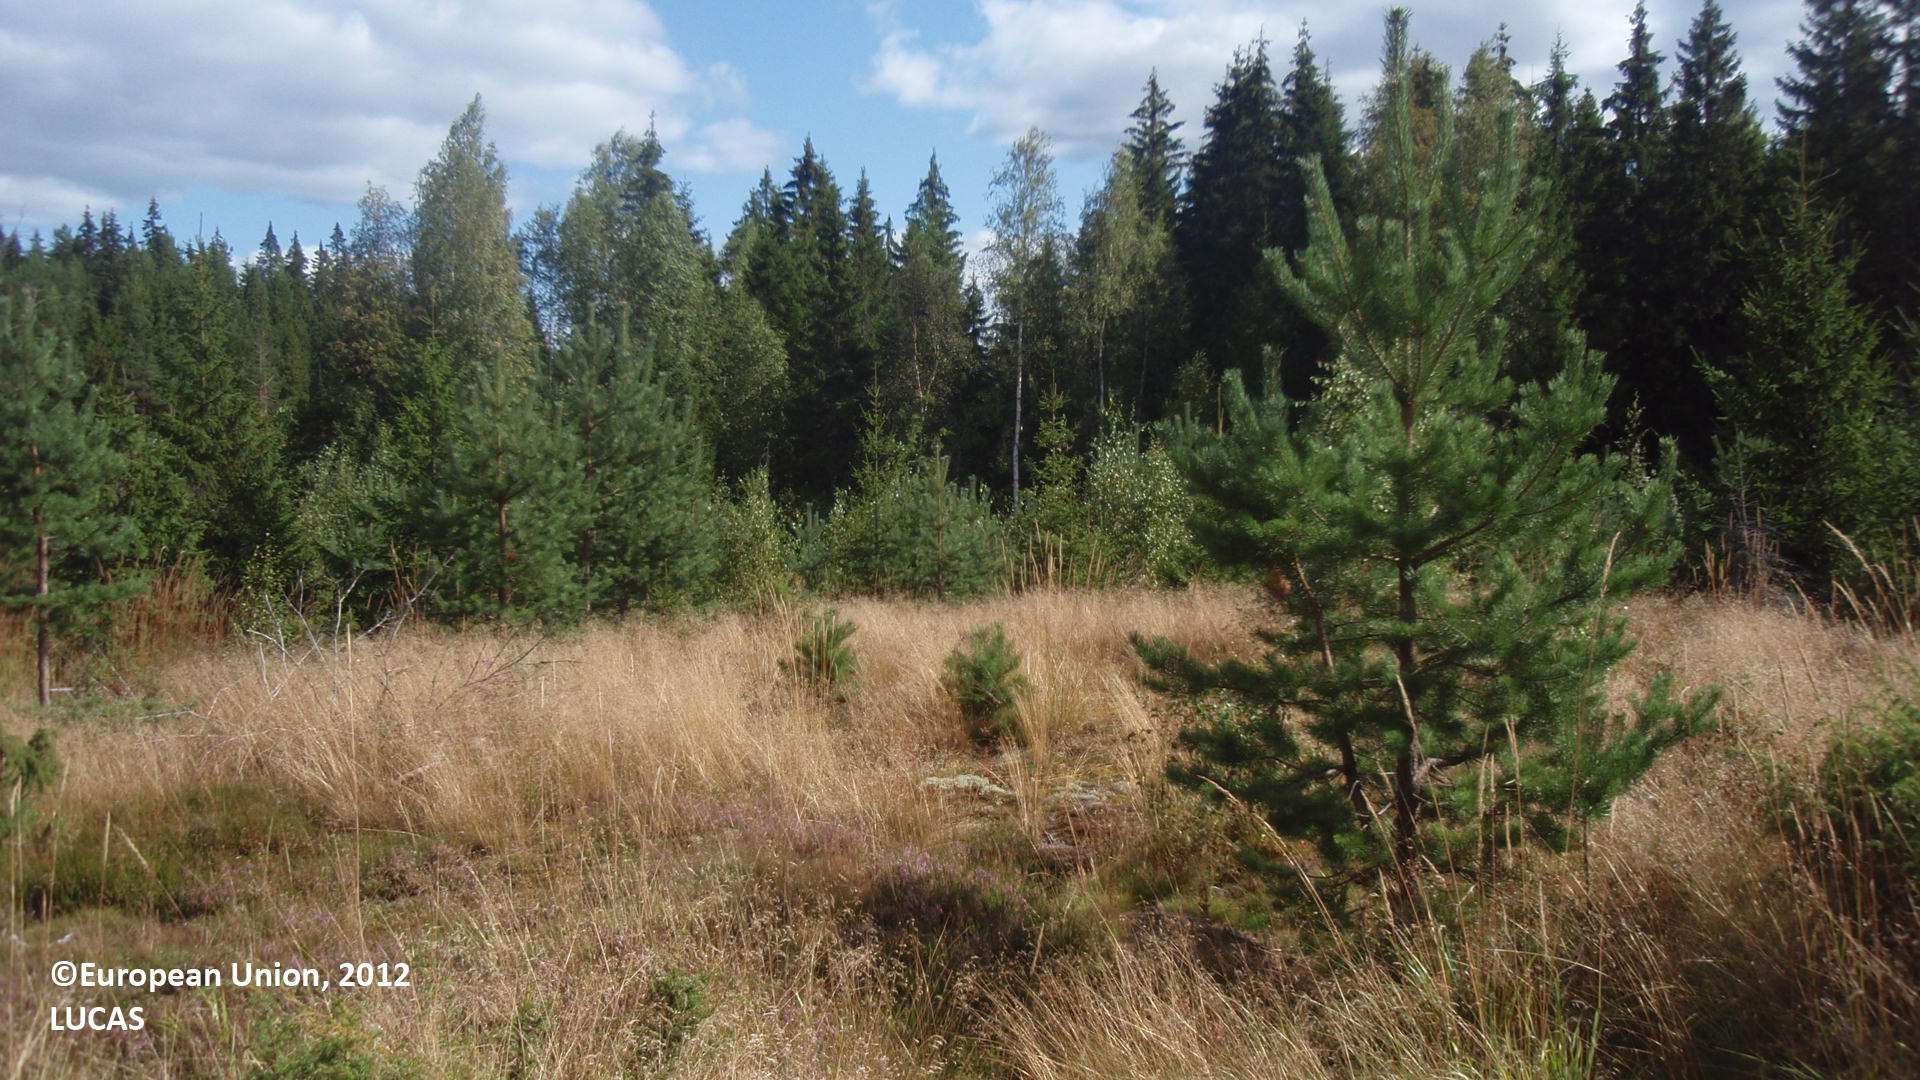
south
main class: Grassland
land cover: Grassland with sparse tree/shrub cover
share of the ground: 50 - 75 %
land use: Forestry
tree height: > 5 m
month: August
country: FI
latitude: 60.7246
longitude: 27.4712
